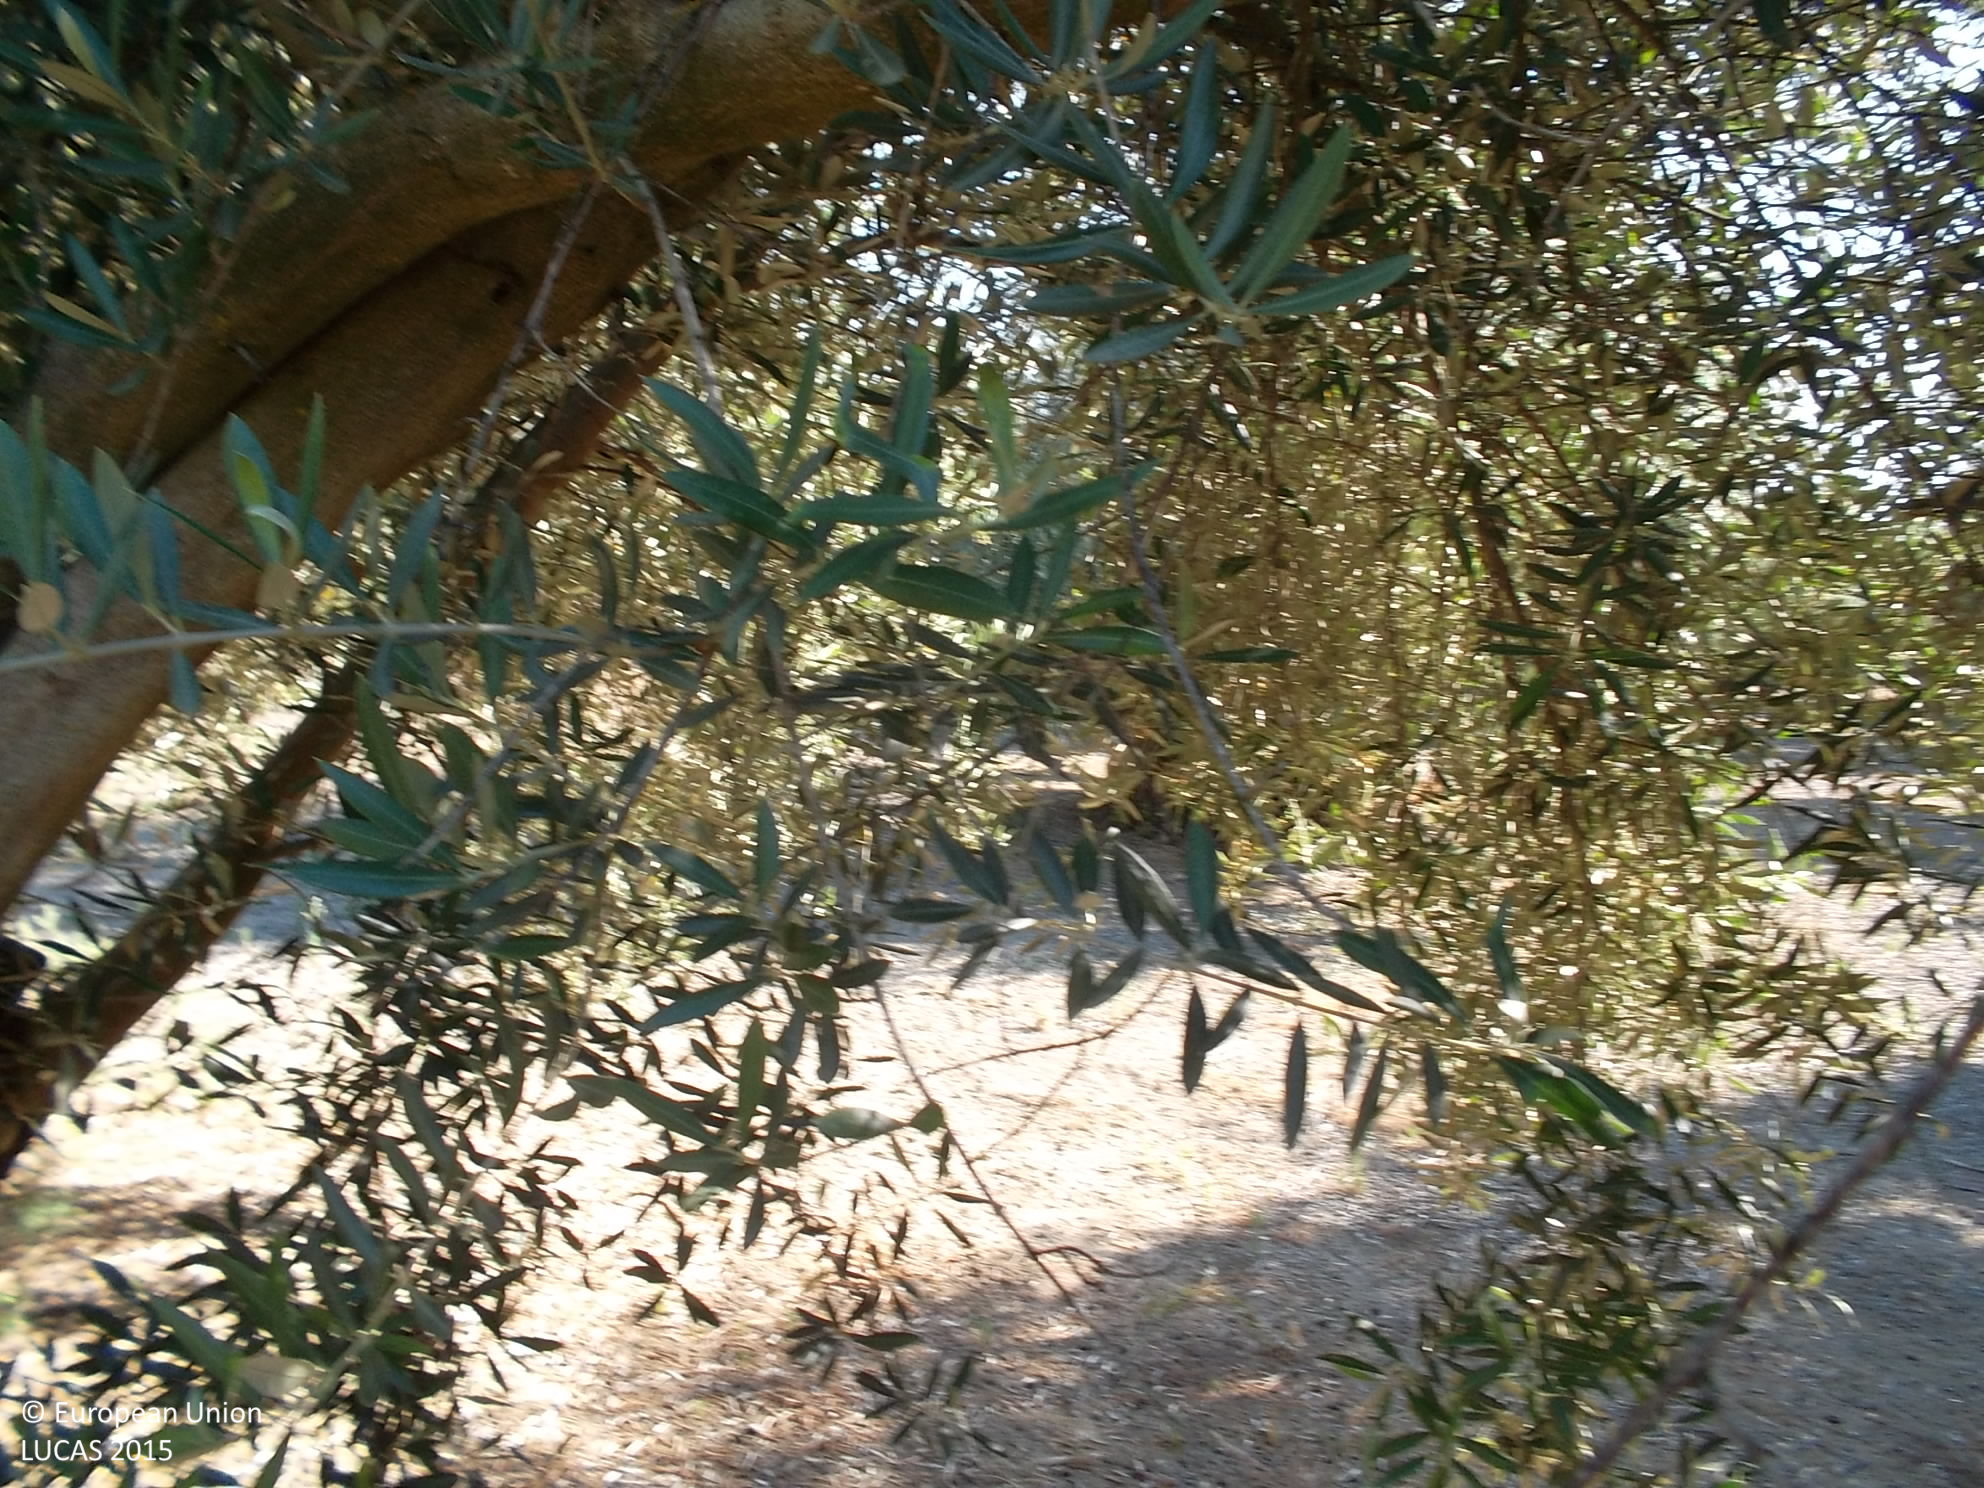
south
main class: Cropland
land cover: Olive groves
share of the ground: 50 - 75 %
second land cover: Other bare soil
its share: > 75 %
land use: Agriculture (excluding fallow land and kitchen gardens)
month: June
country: ES
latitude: 37.9983
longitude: -3.0586
